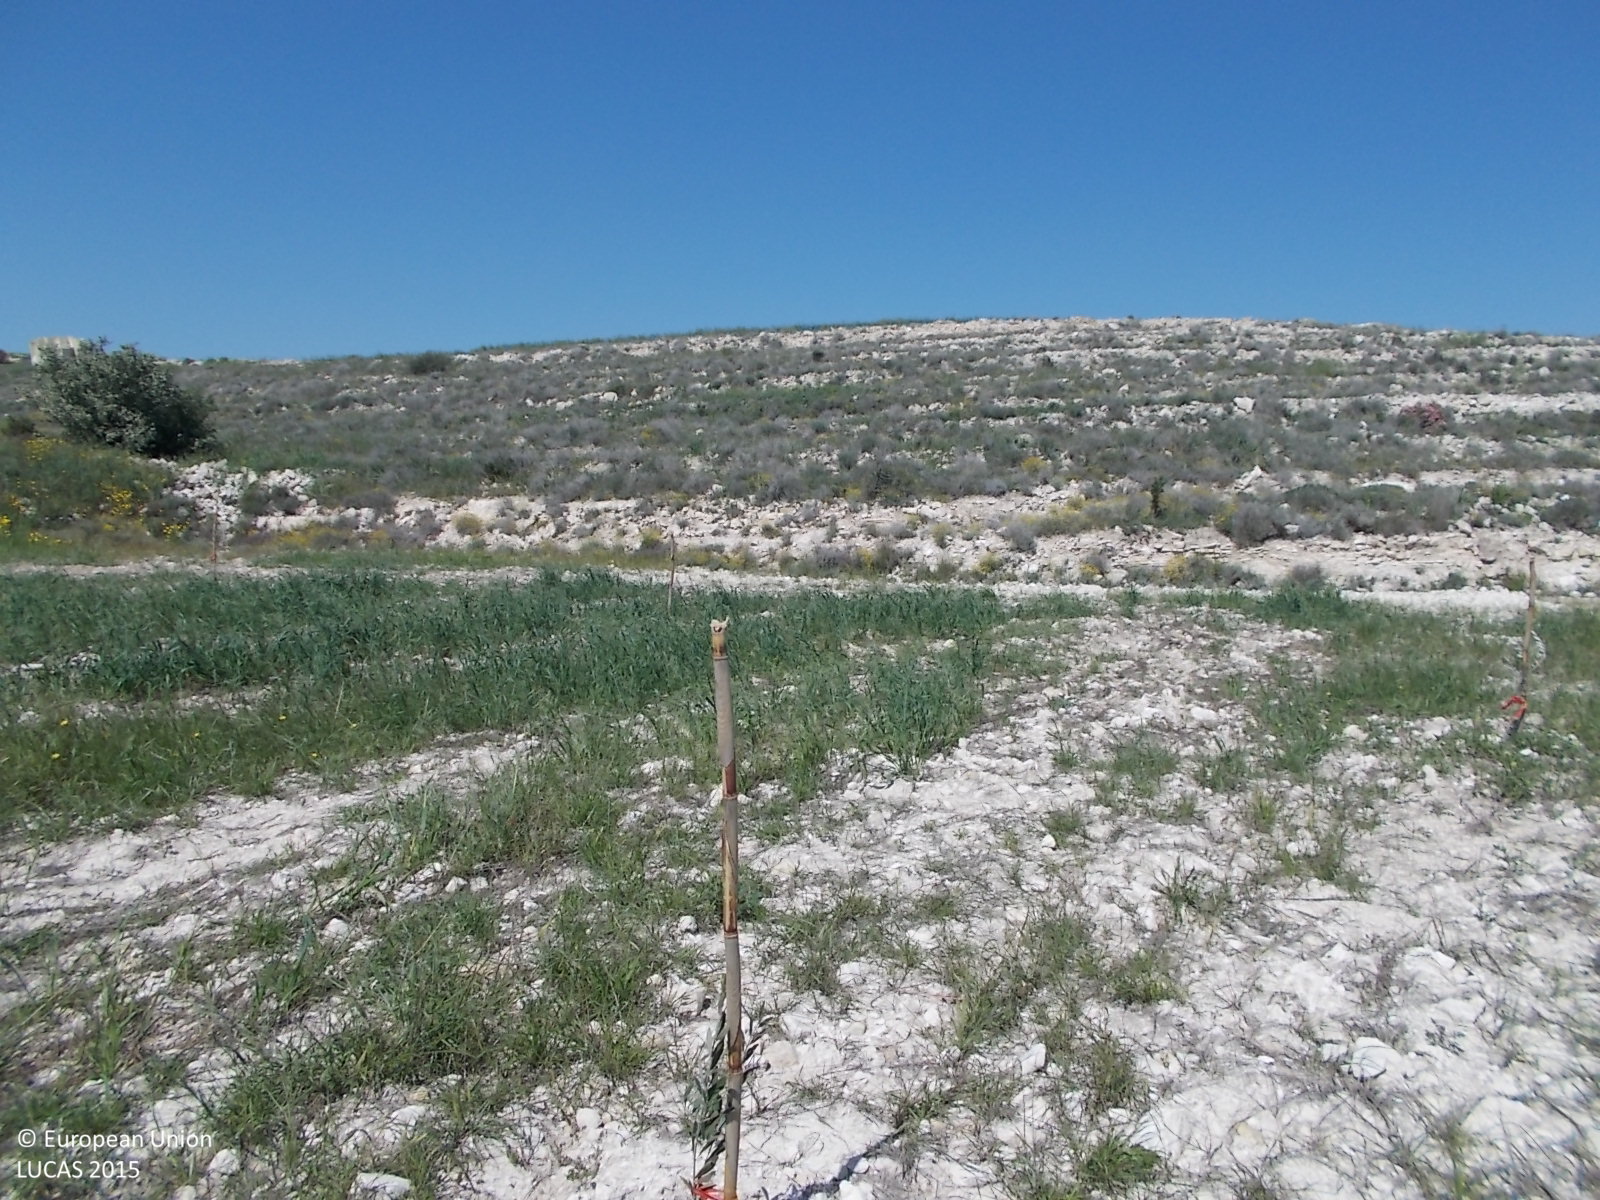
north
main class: Cropland
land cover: Olive groves
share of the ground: < 10 %
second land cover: Grassland without tree/shrub cover
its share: 25 - 50 %
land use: Agriculture (excluding fallow land and kitchen gardens)
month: April
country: CY
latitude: 35.0089
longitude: 33.5476
